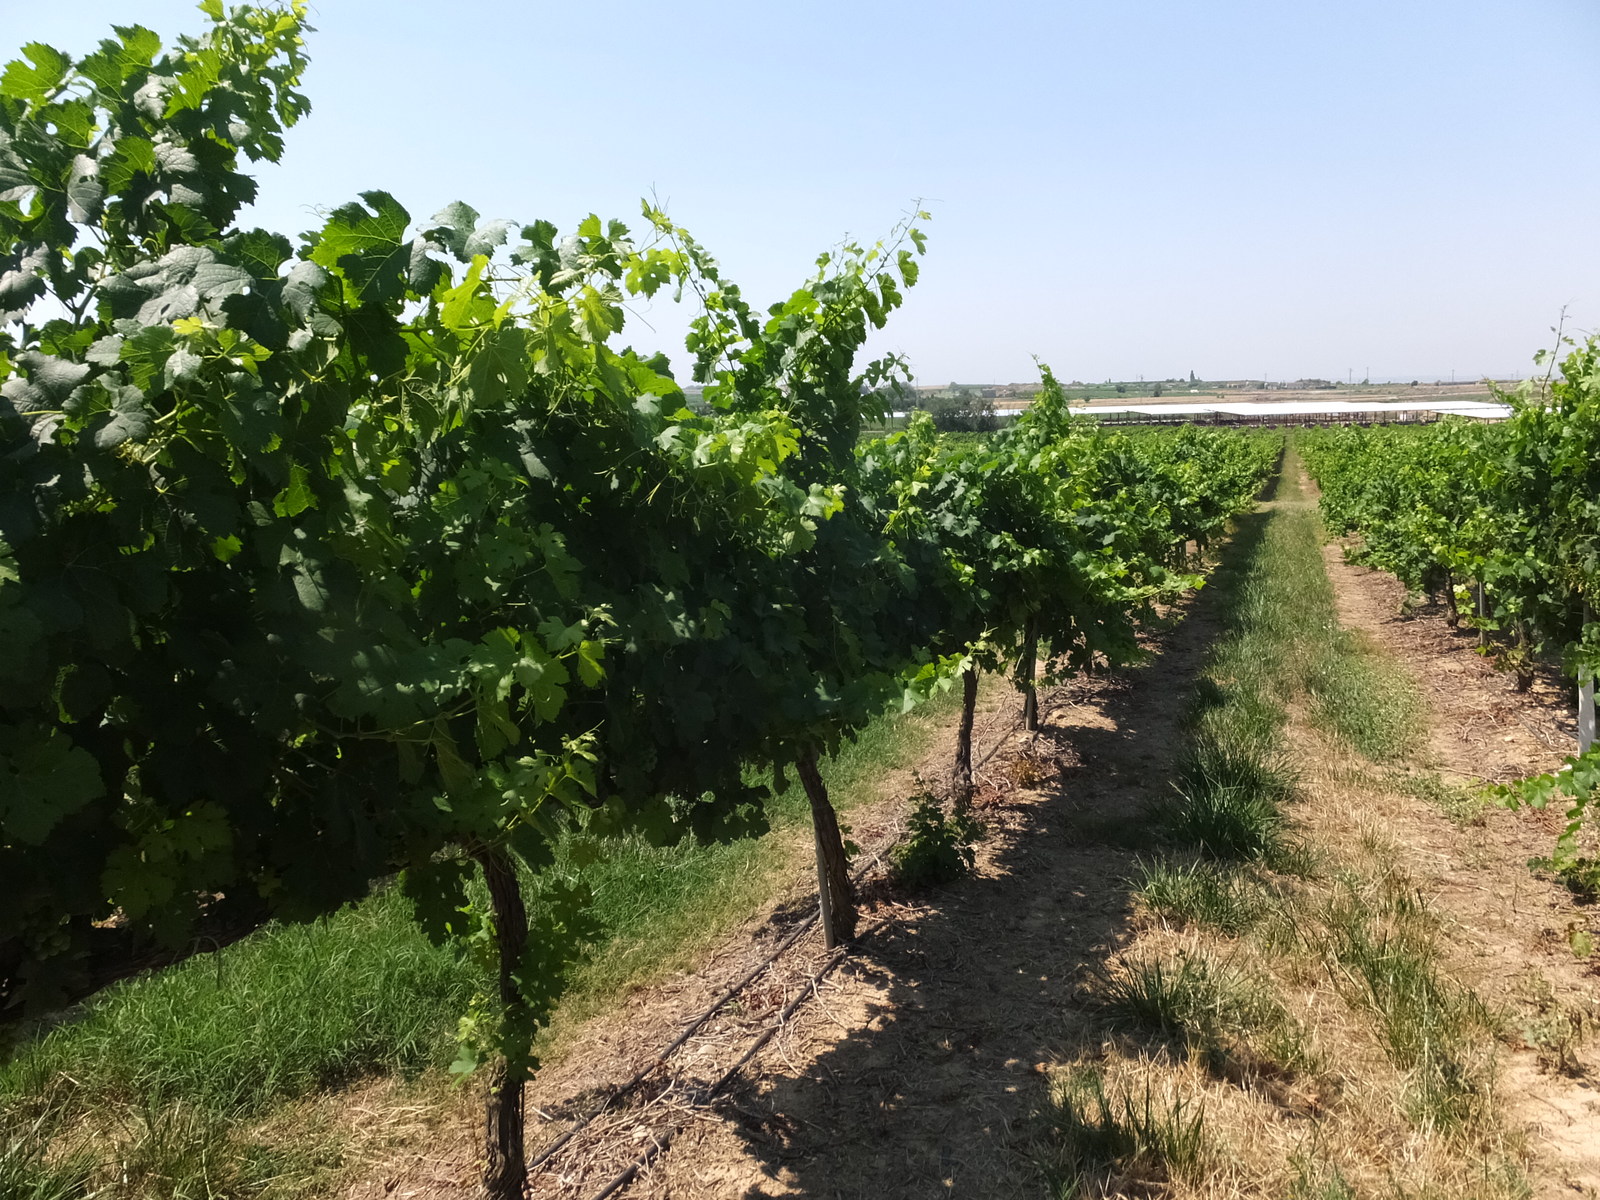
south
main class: Cropland
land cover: Vineyards
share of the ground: > 75 %
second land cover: Spontaneously vegetated surfaces
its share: 25 - 50 %
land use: Agriculture (excluding fallow land and kitchen gardens)
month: June
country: ES
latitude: 41.7451
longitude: 0.4259
